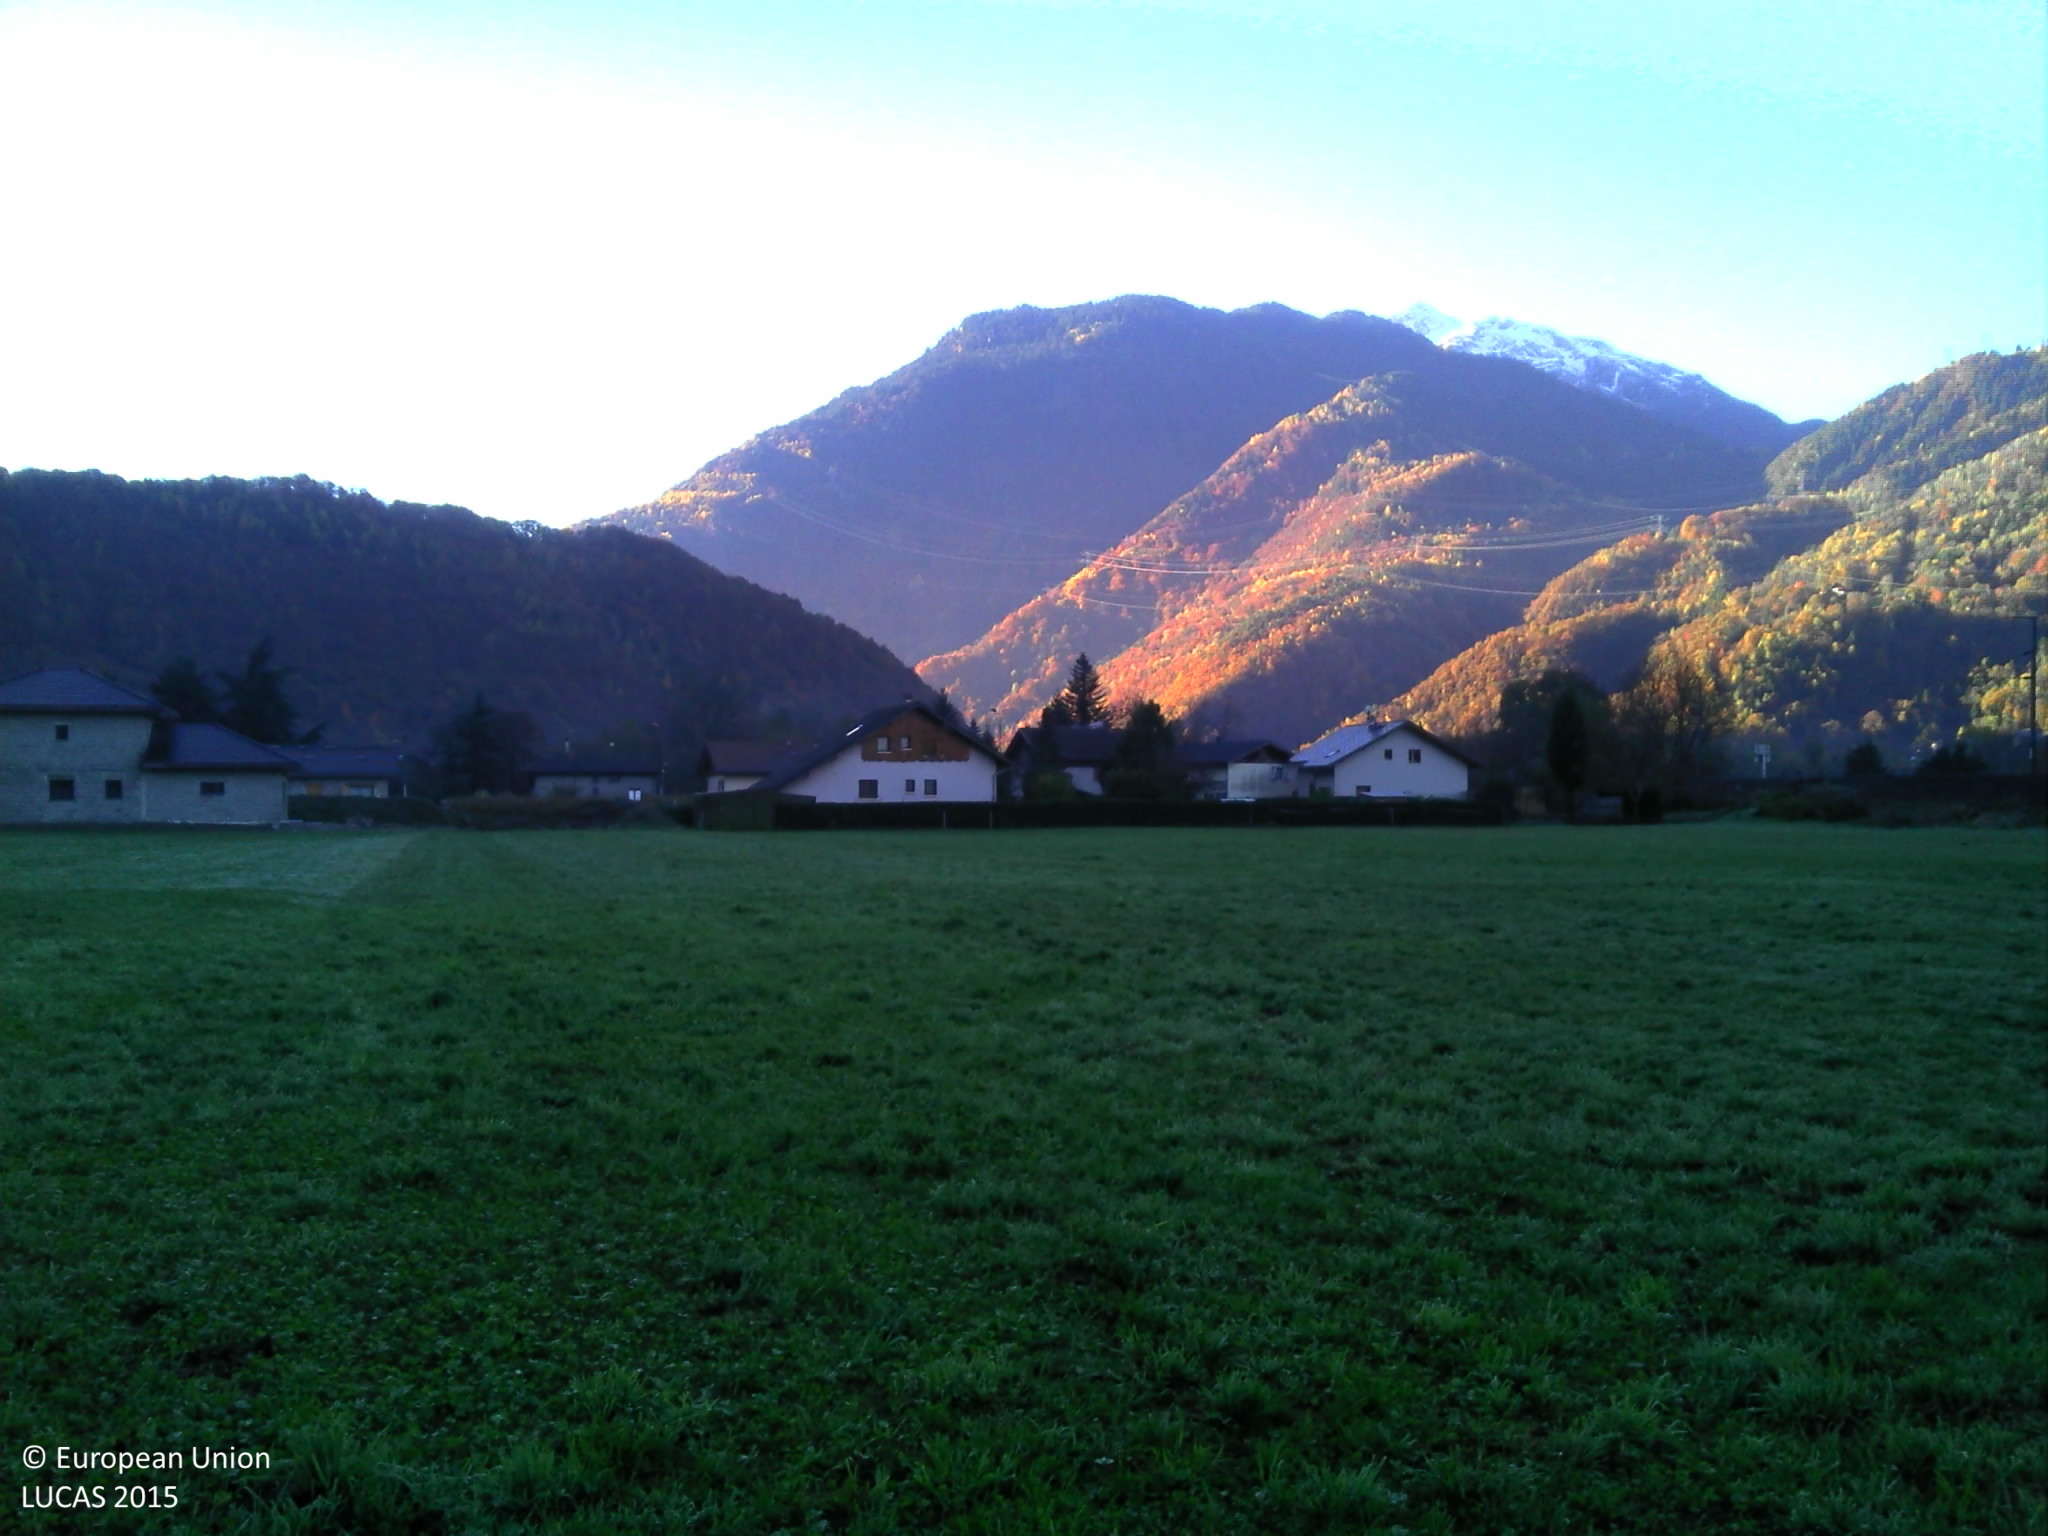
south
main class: Grassland
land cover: Grassland without tree/shrub cover
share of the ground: > 75 %
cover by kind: herbaceous plants 100 %
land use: Agriculture (excluding fallow land and kitchen gardens)
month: October
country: FR
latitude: 45.6072
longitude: 6.4527
